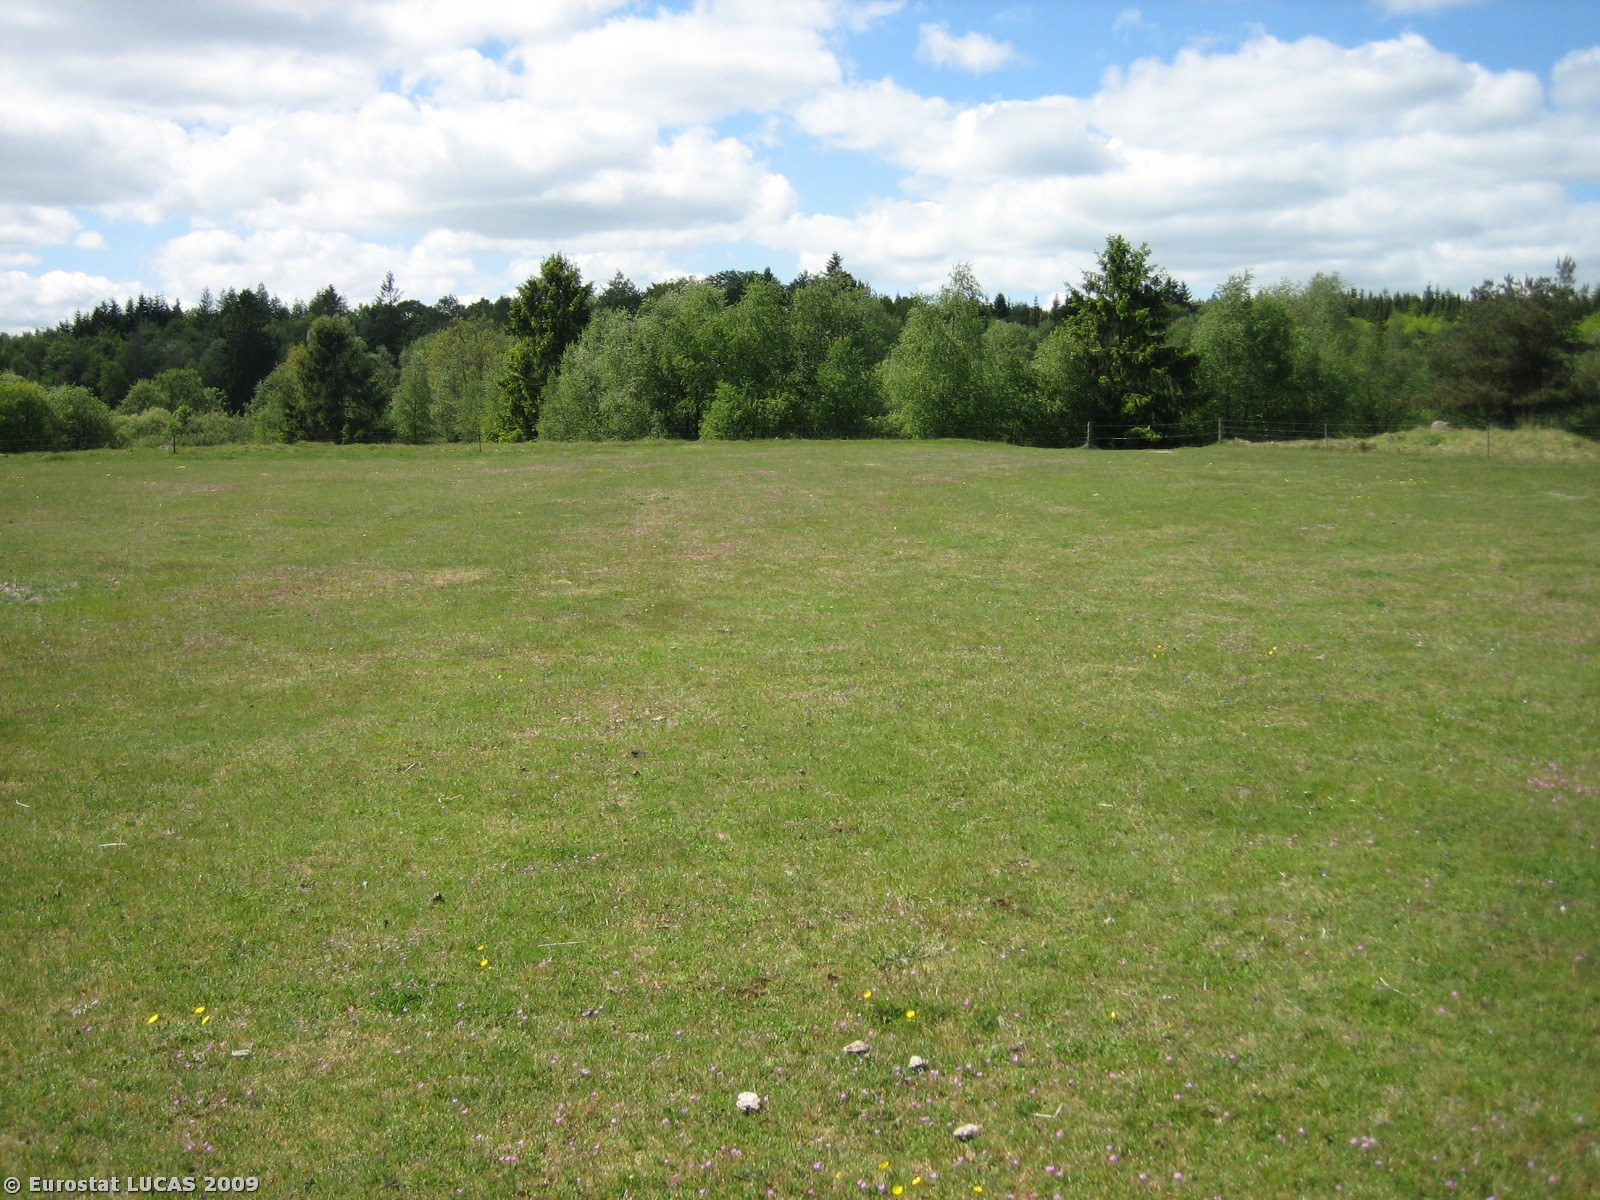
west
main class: Grassland
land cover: Grassland without tree/shrub cover
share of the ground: > 75 %
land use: Residential
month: May
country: DK
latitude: 56.0399
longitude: 8.9899
